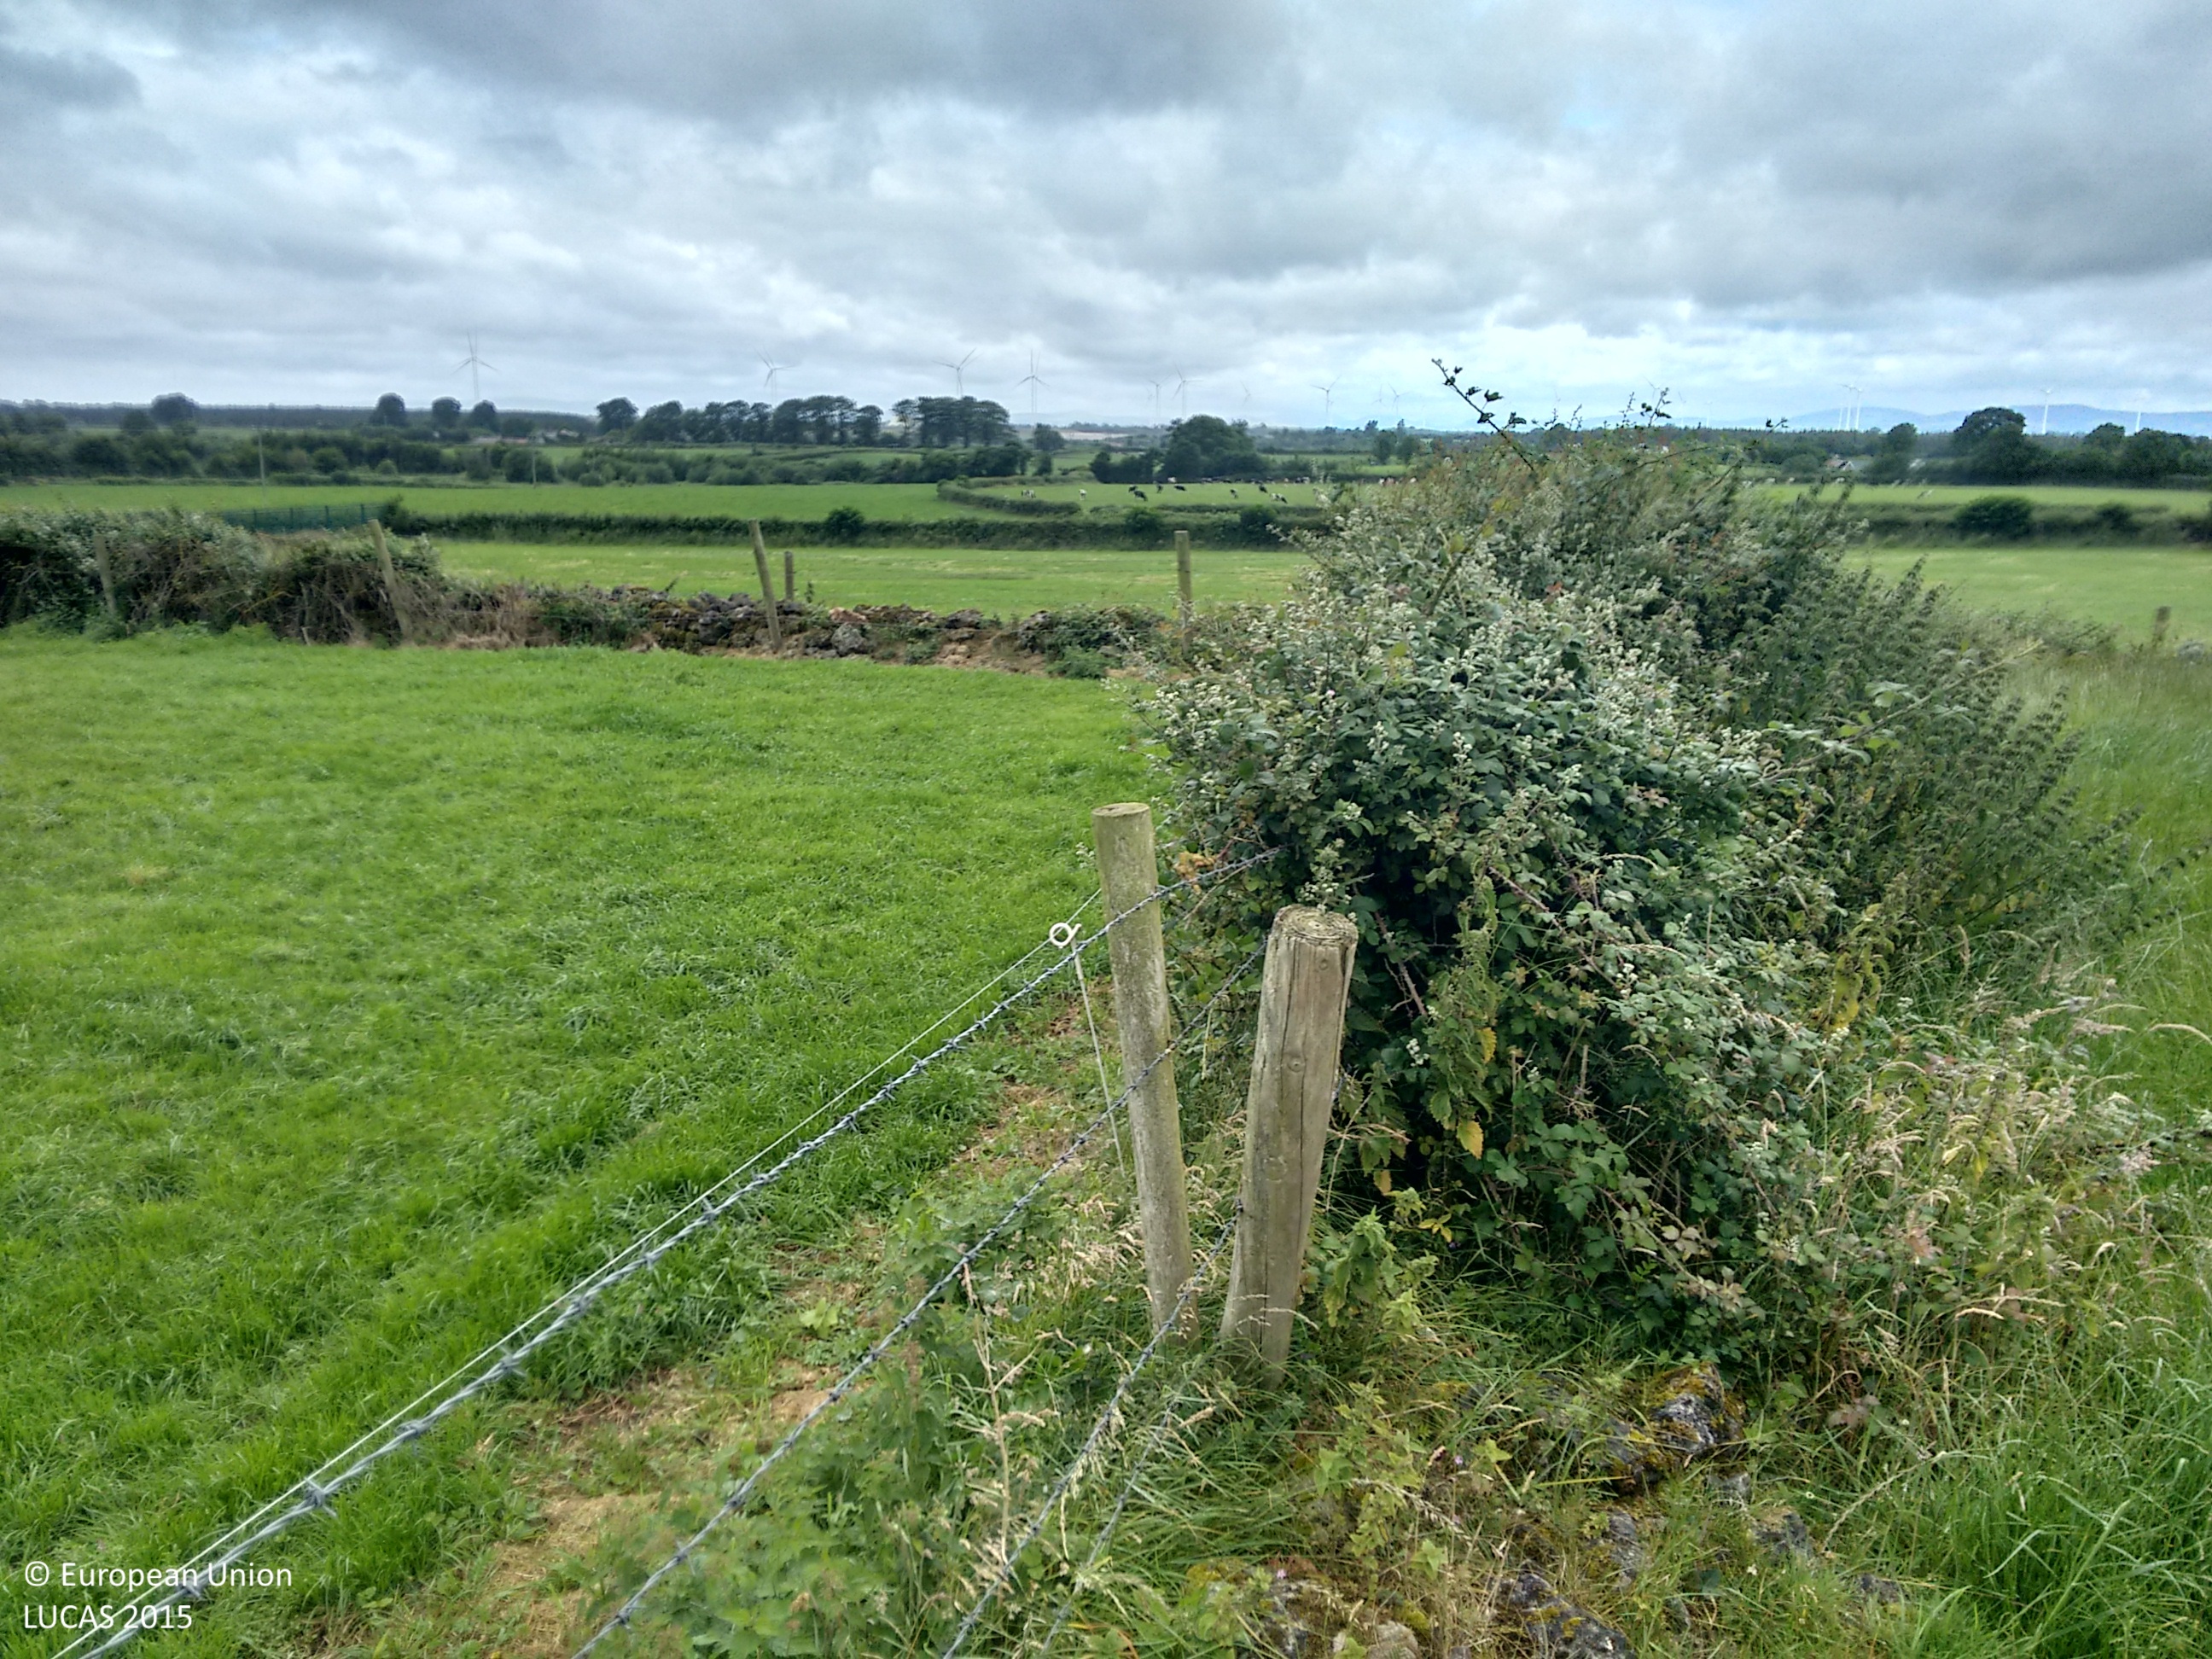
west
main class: Grassland
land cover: Grassland without tree/shrub cover
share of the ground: > 75 %
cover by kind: herbaceous plants 100 %
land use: Agriculture (excluding fallow land and kitchen gardens)
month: July
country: IE
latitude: 52.7562
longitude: -7.6327
